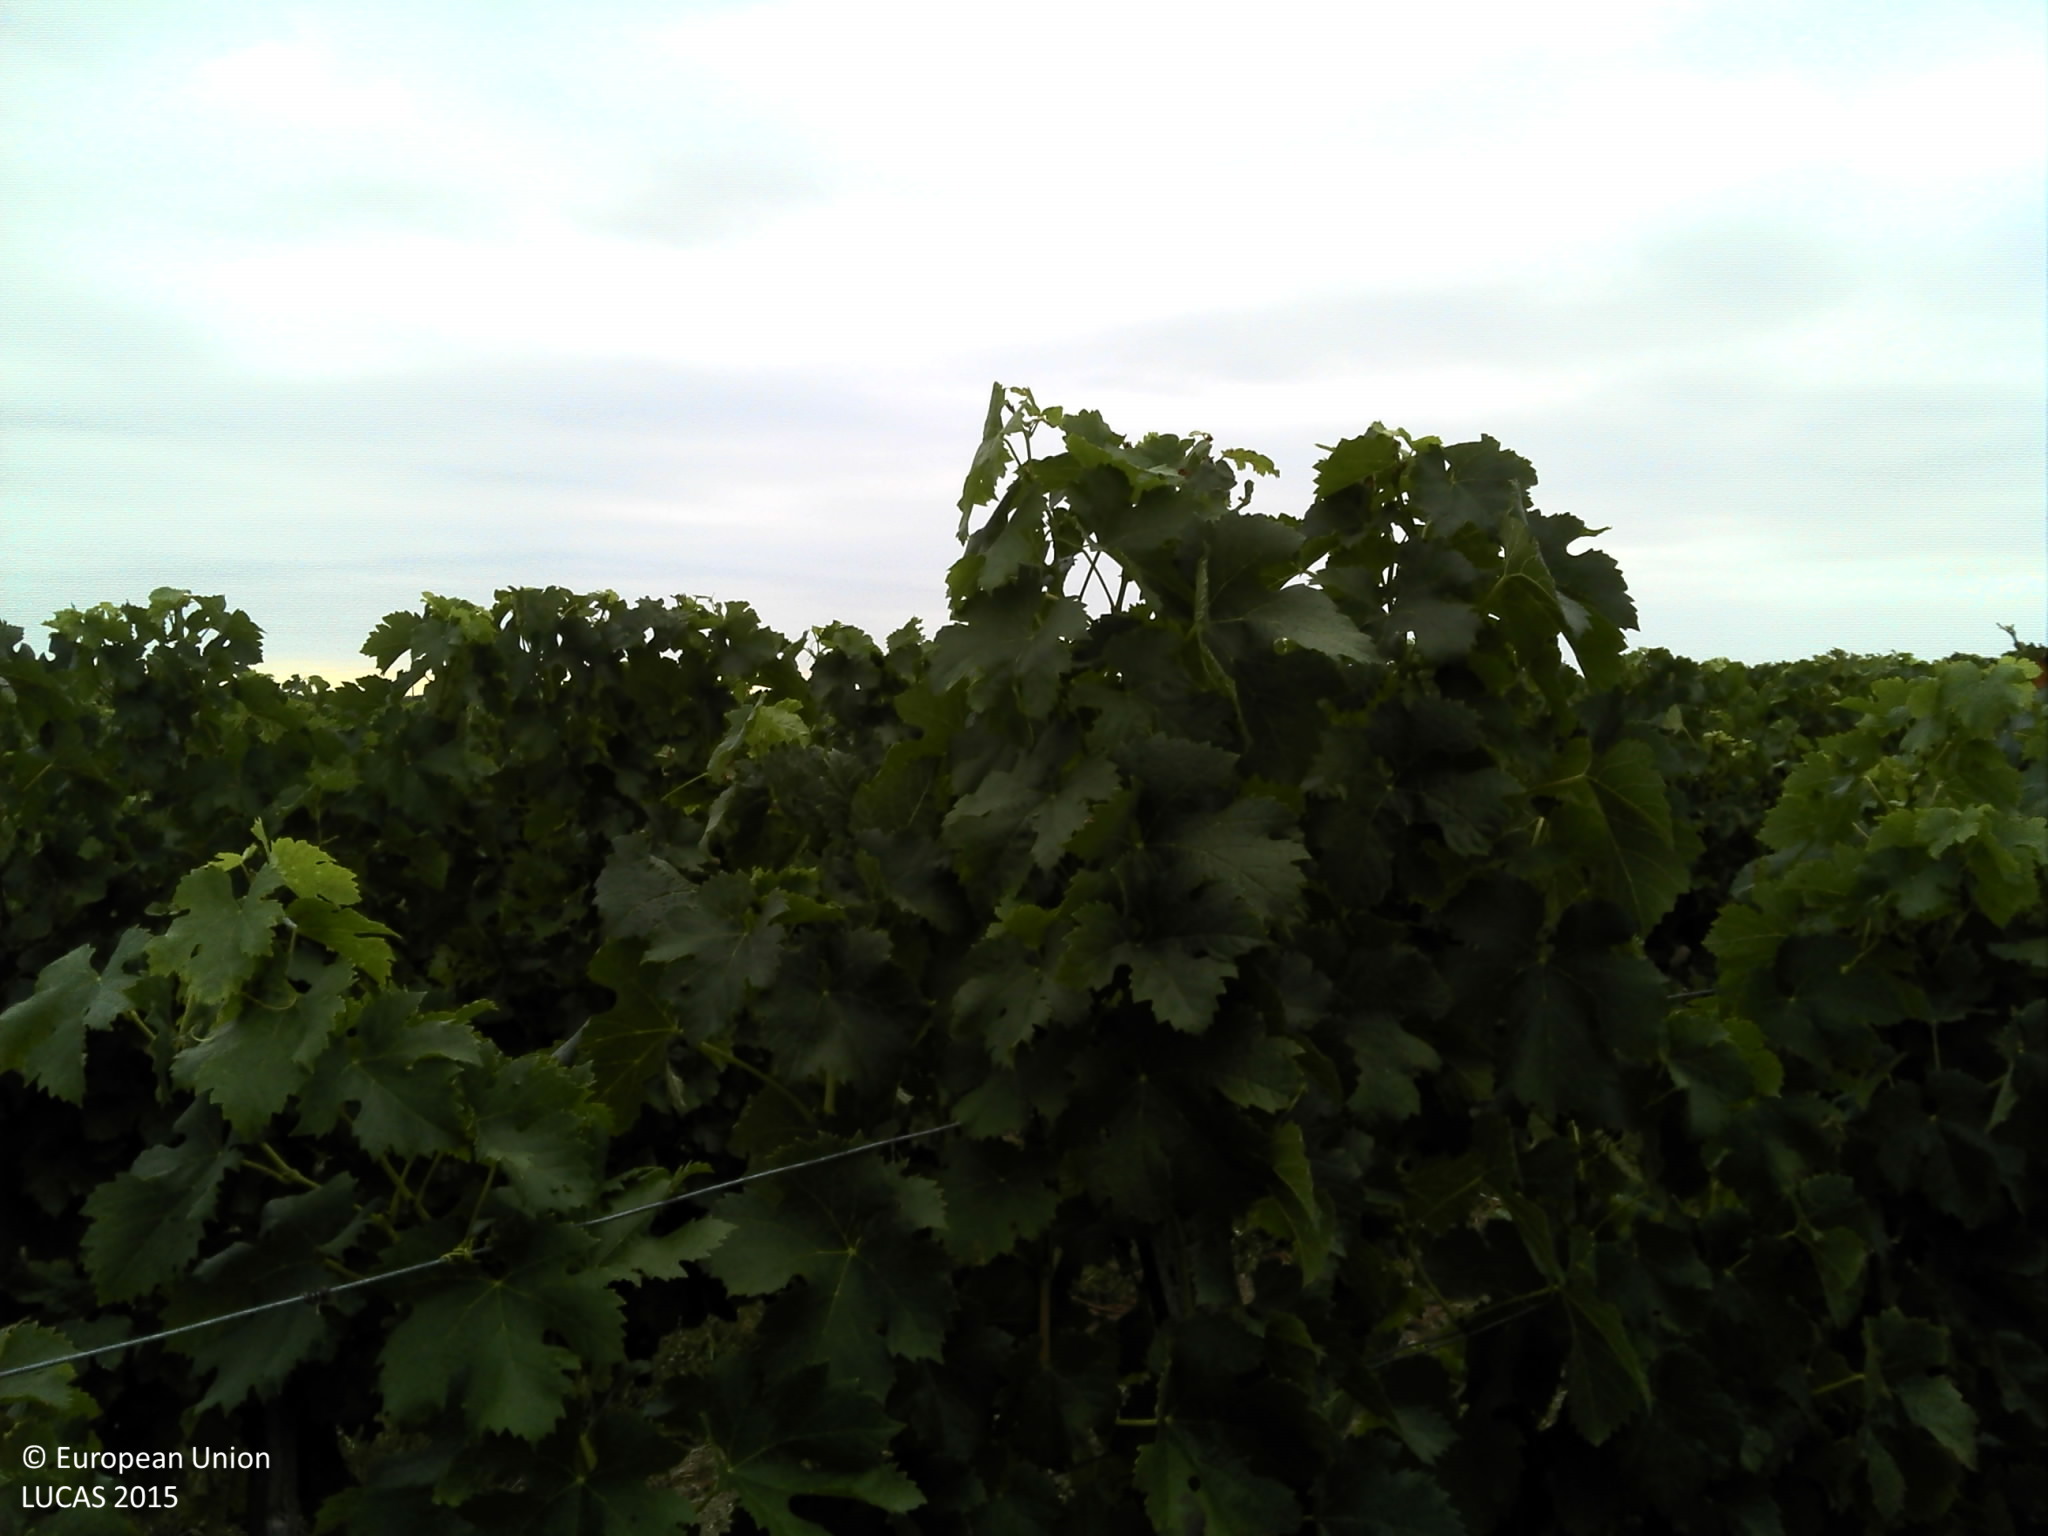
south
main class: Cropland
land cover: Vineyards
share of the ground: 25 - 50 %
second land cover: Grassland without tree/shrub cover
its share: > 75 %
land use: Agriculture (excluding fallow land and kitchen gardens)
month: August
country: FR
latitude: 45.1035
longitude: -0.5298
